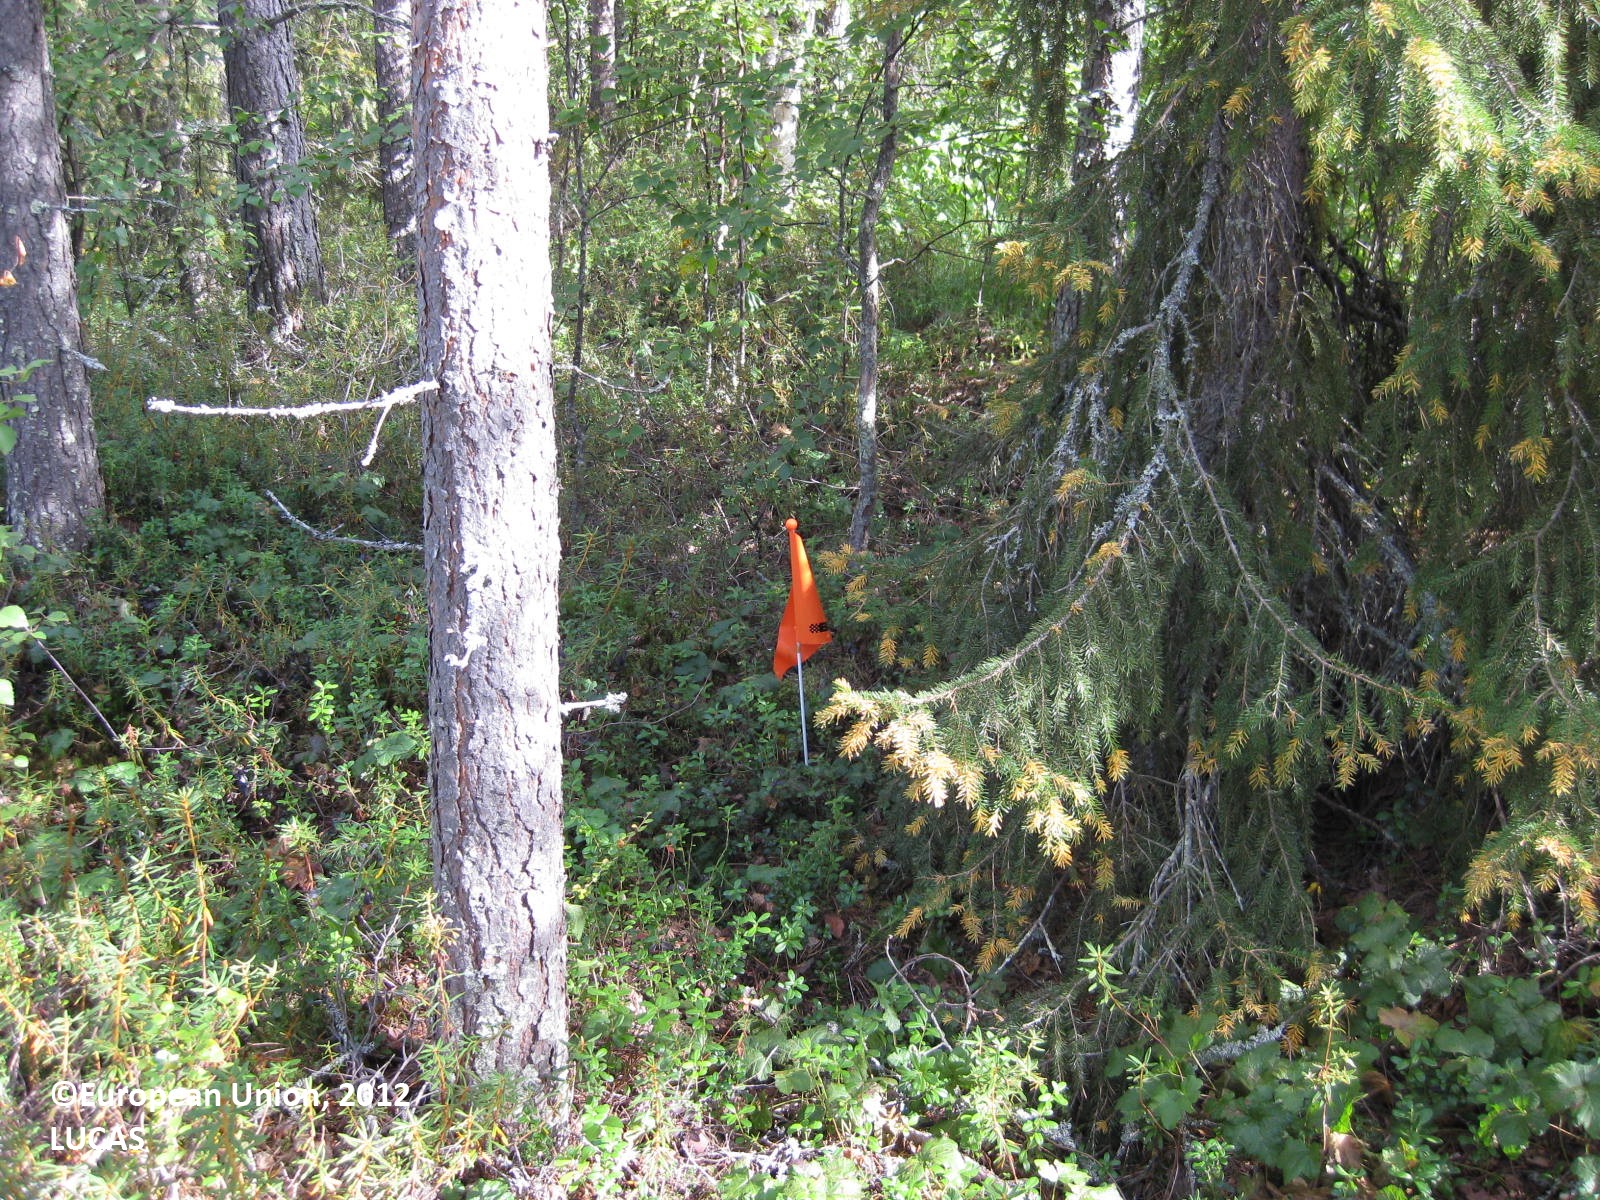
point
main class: Woodland
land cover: Pine dominated mixed woodland
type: boreal forest
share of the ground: > 75 %
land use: Forestry
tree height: > 5 m
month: August
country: FI
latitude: 66.2445
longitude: 28.8722
